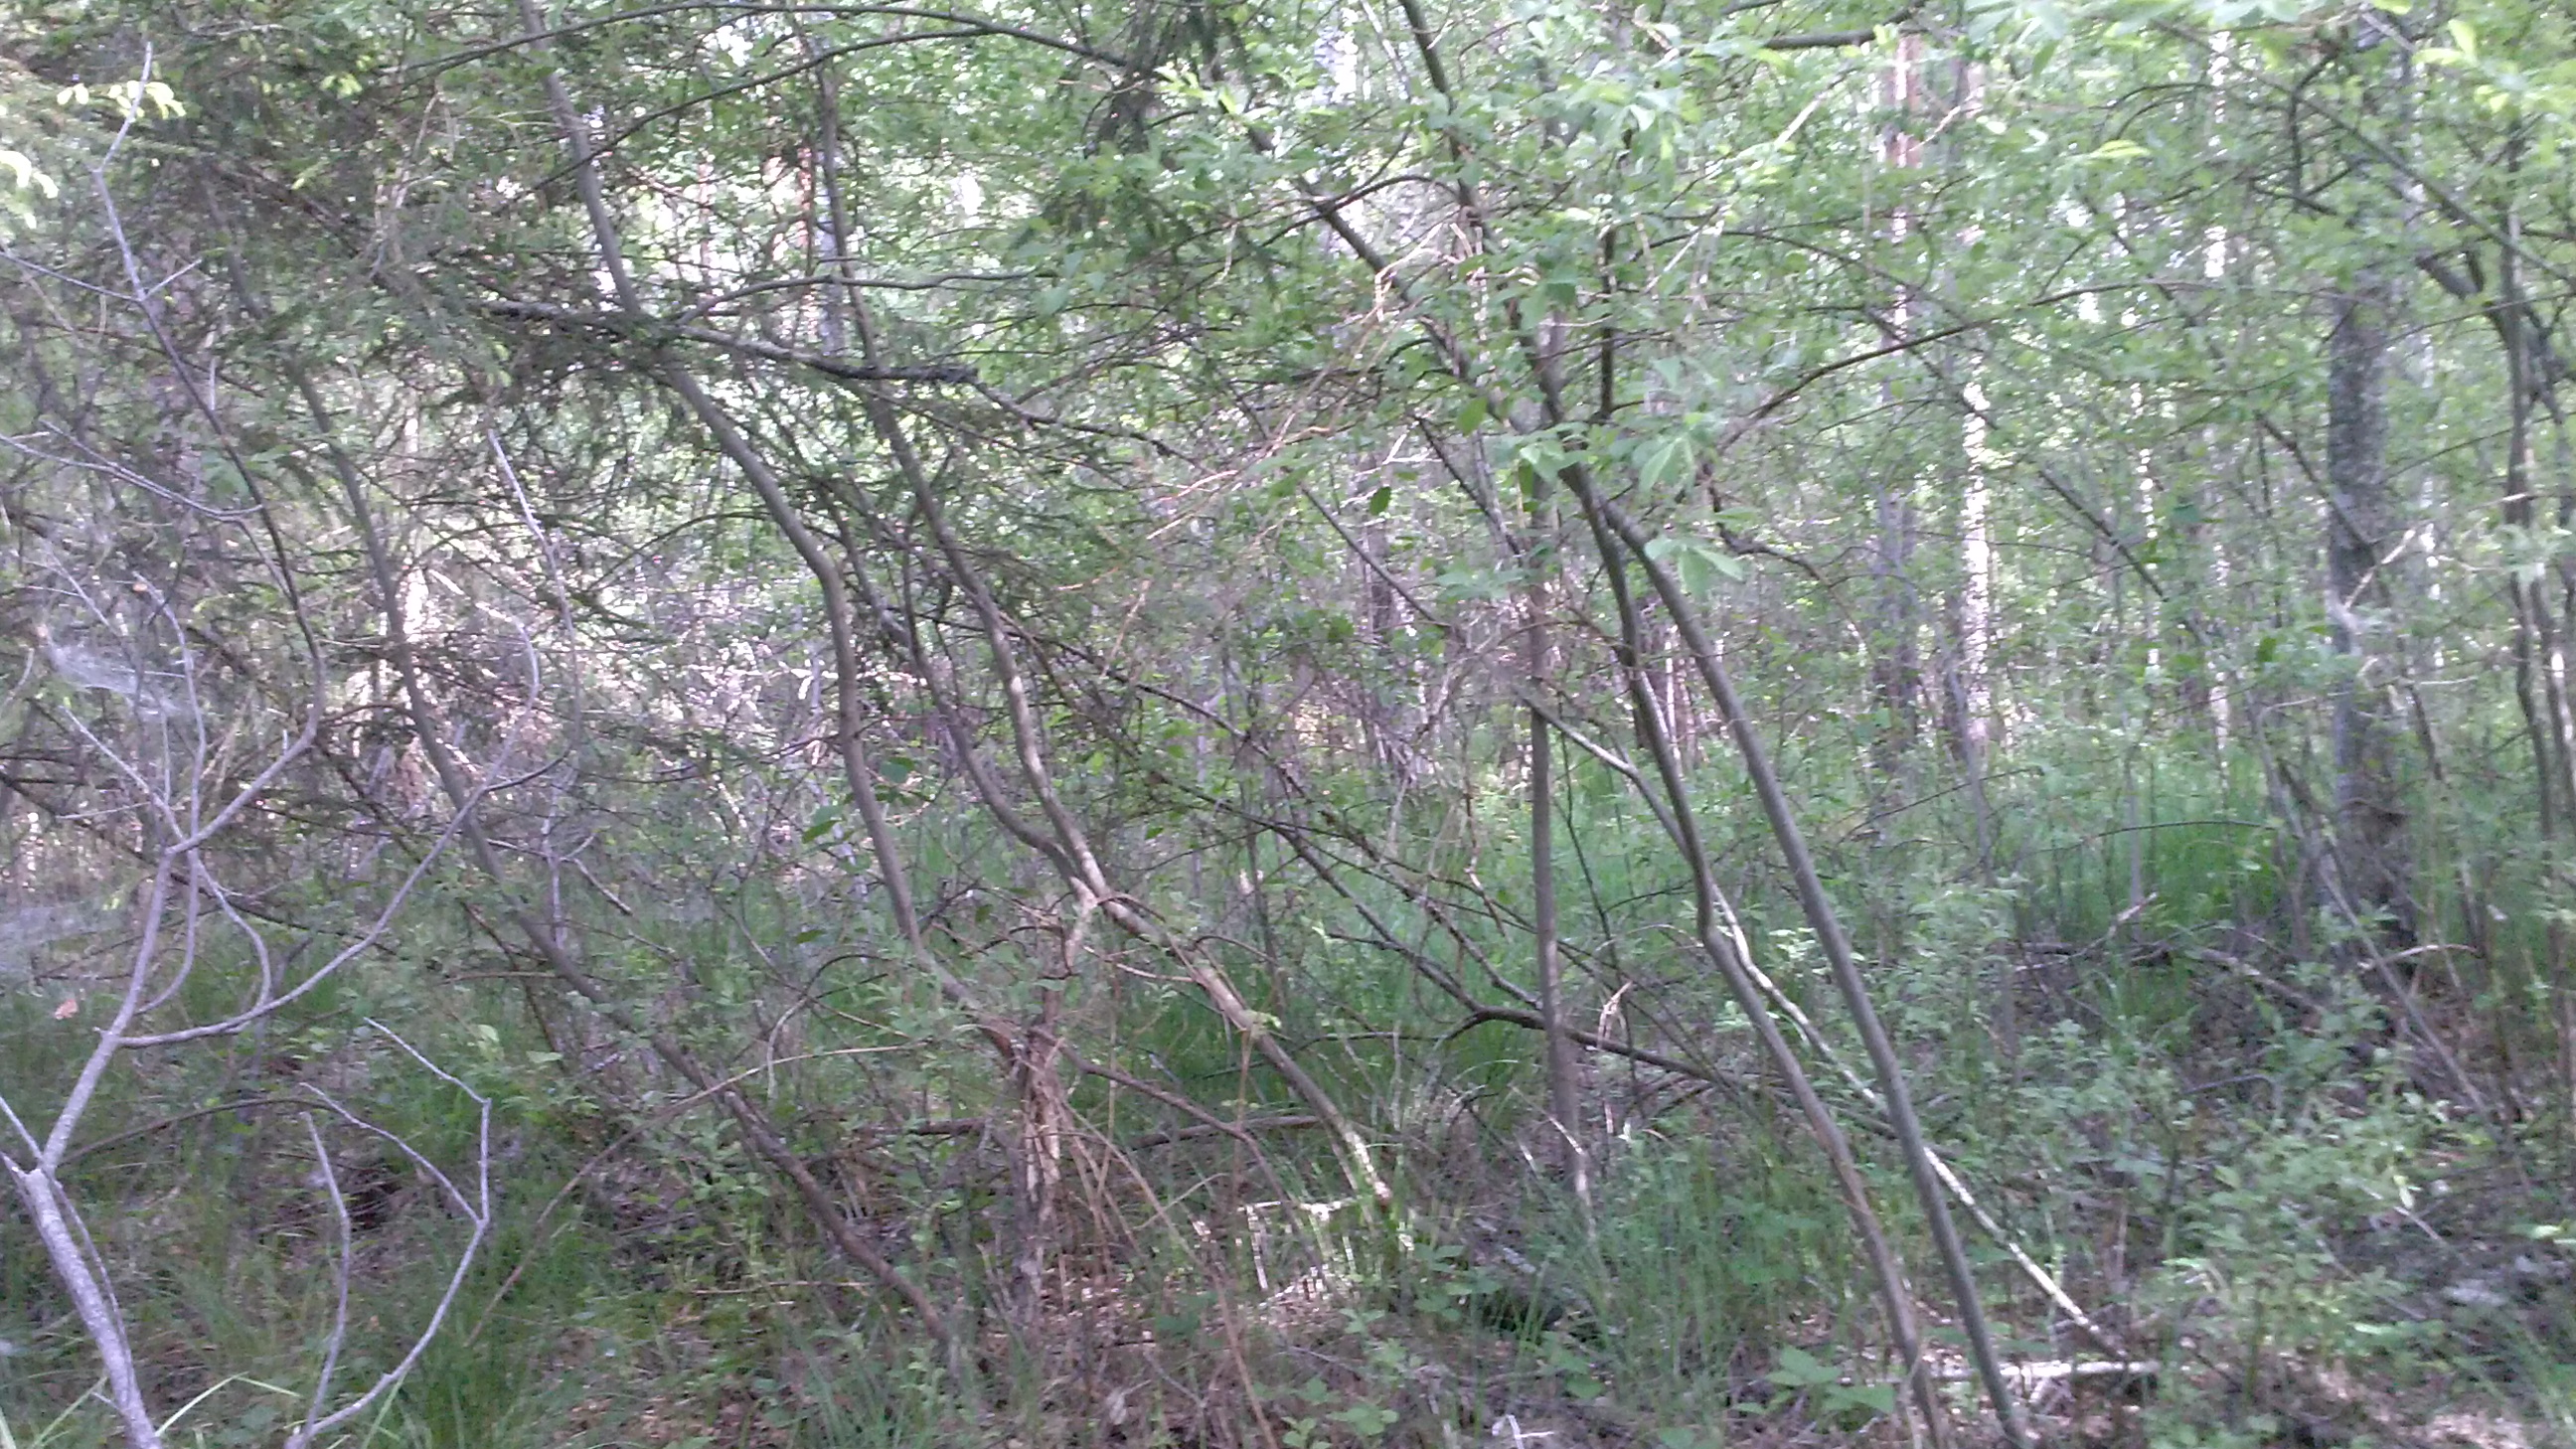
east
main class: Woodland
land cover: Broadleaved woodland
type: non-riverine alder, birch or aspen forest
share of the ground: > 75 %
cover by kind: broadleaved forest trees 85 %, coniferous forest trees 5 %, shrubs 5 %, herbaceous plants 5 %
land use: Forestry
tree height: > 5 m
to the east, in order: Broadleaved woodland; Pine dominated mixed woodland; Broadleaved woodland
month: June
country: LV
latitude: 56.3835
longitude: 27.4258
